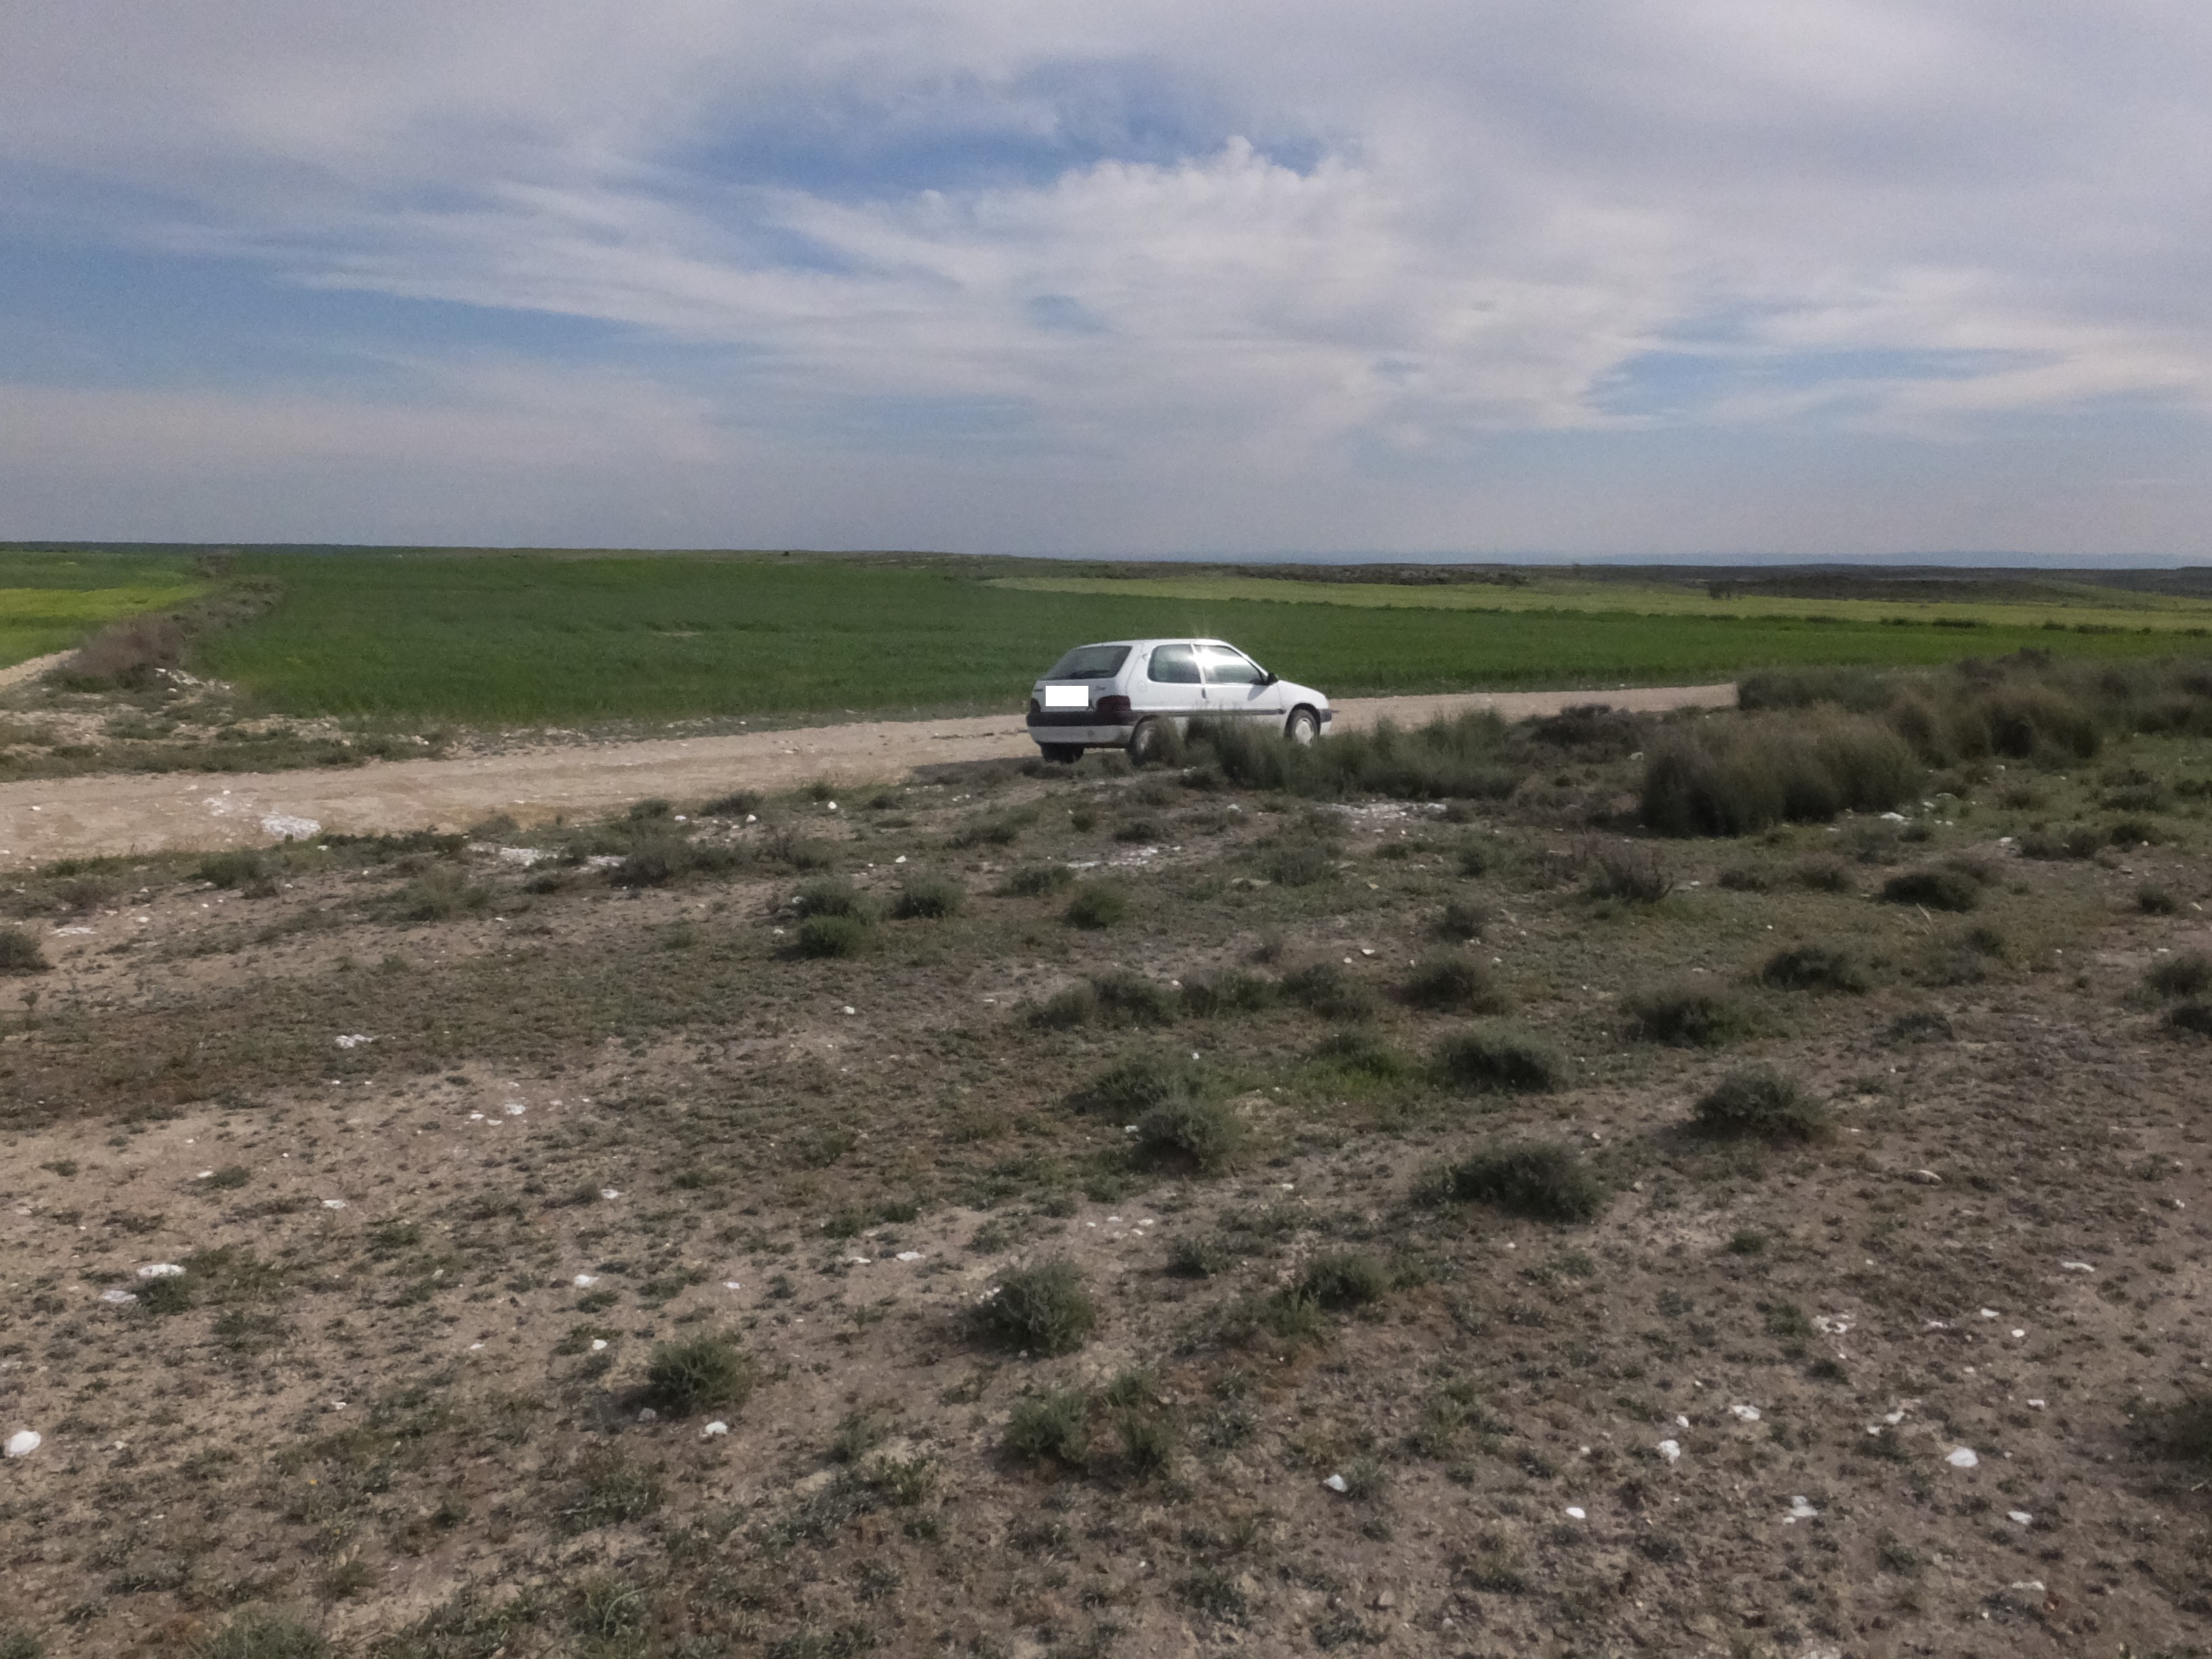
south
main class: Grassland
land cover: Grassland without tree/shrub cover
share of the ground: 50 - 75 %
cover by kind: herbaceous plants 75 %, unconsolidated bare surface 25 %
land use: Semi-natural and natural areas not in use
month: April
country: ES
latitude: 41.5567
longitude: -0.3646
